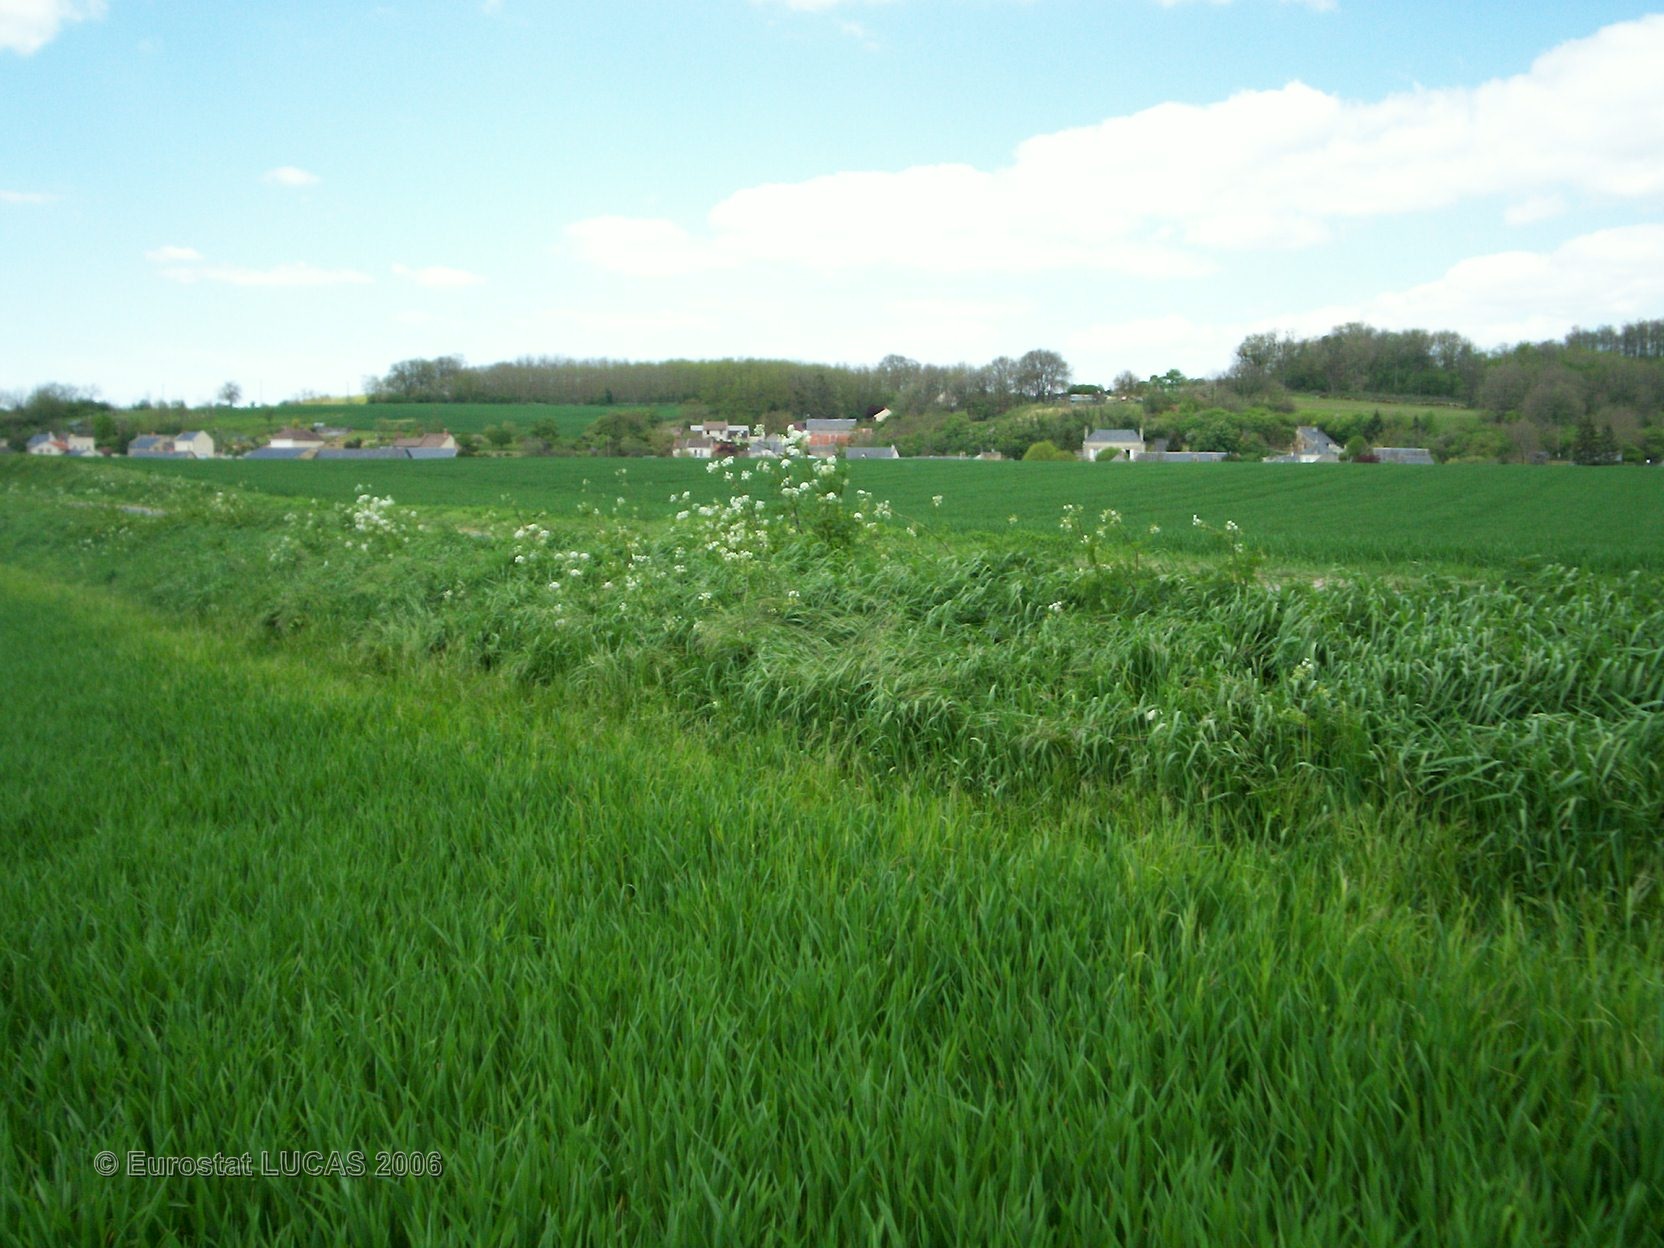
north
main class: Cropland
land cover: Common wheat
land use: Agriculture (excluding fallow land and kitchen gardens)
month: April
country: FR
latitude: 47.1340
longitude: 0.2080
